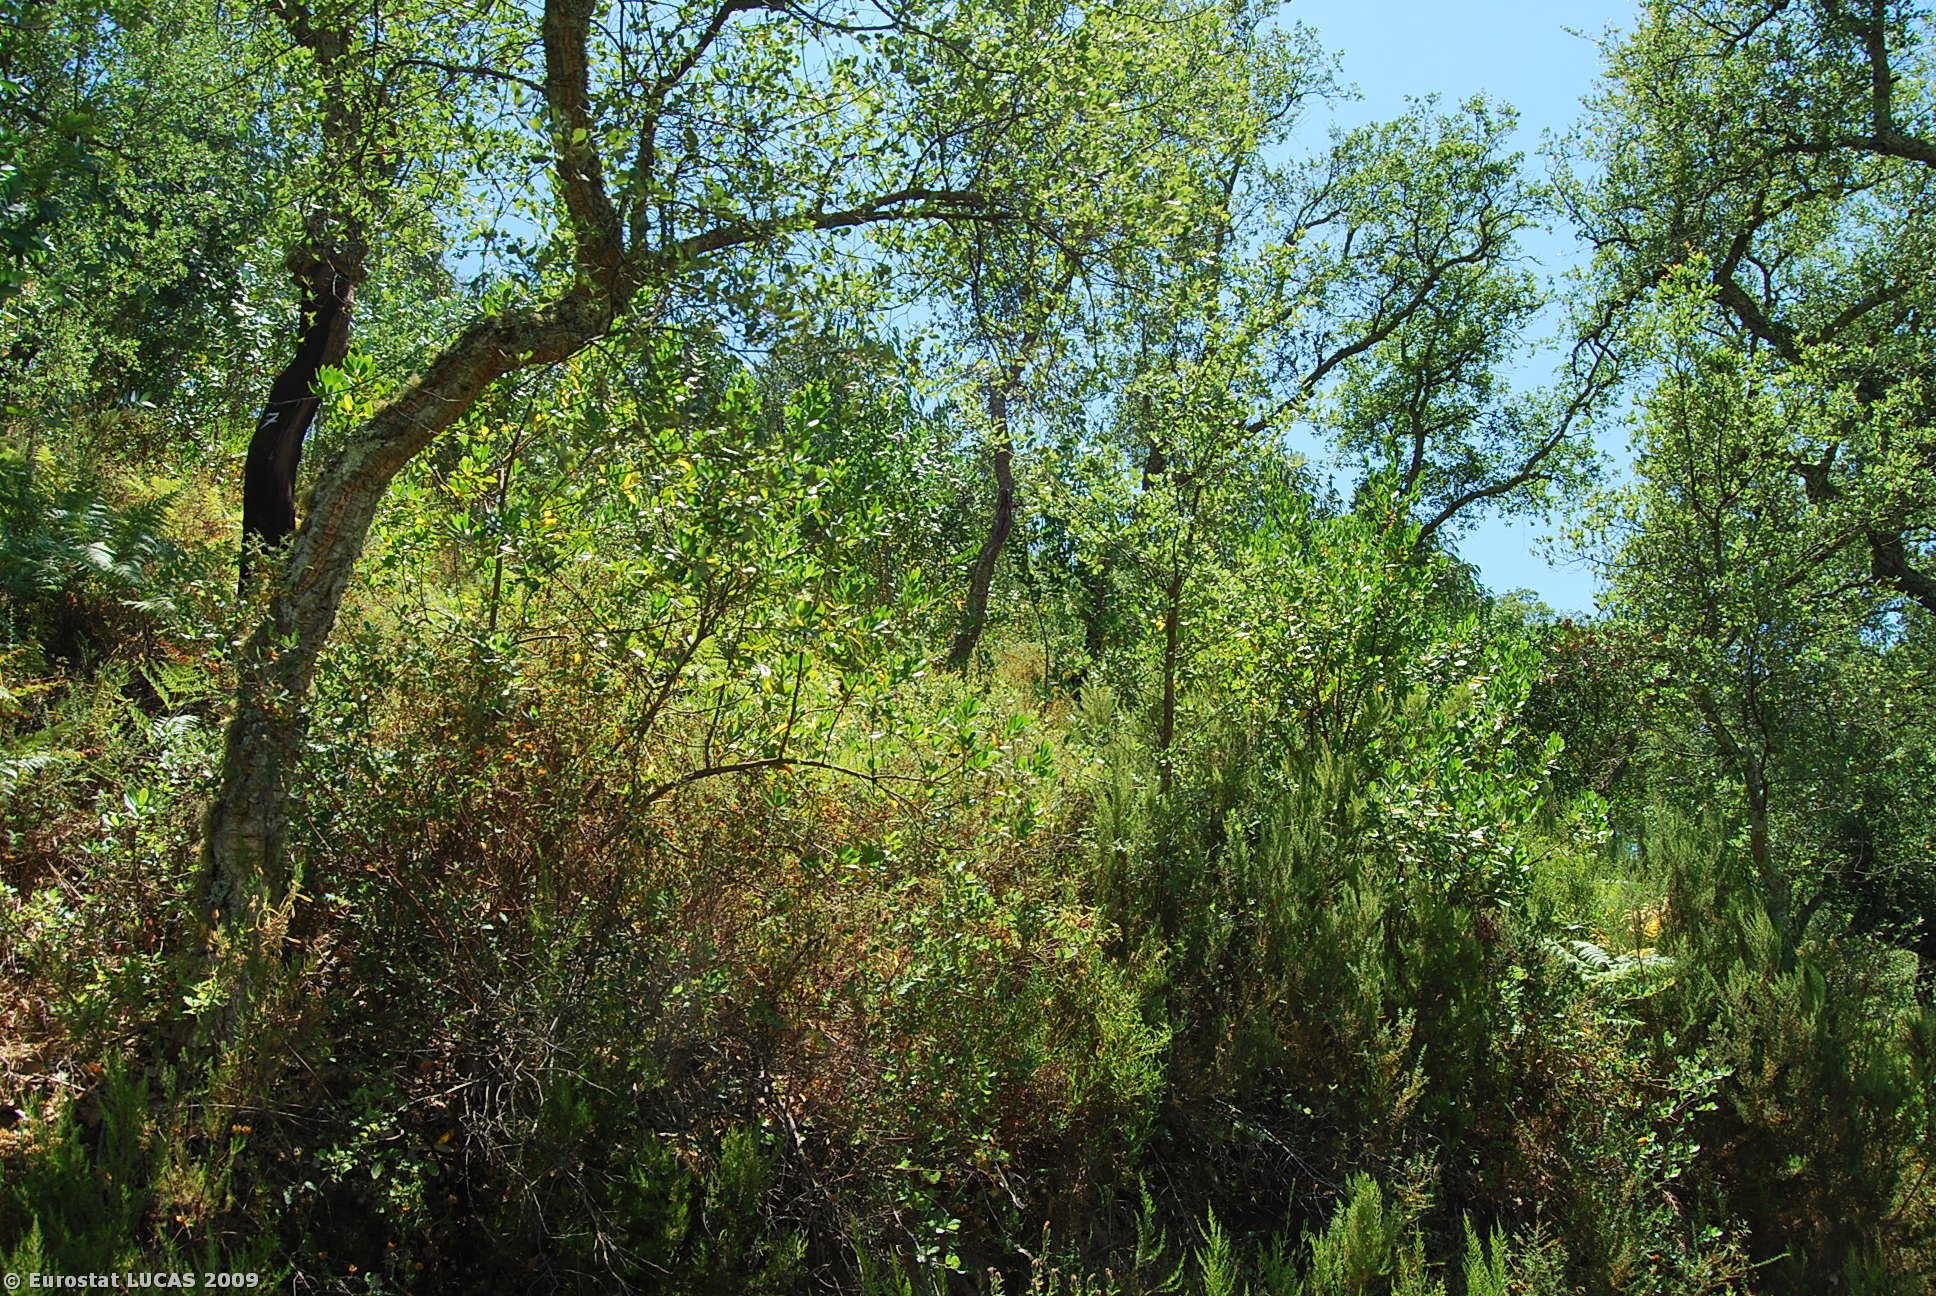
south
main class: Shrubland
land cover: Shrubland with sparse tree cover
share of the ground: > 75 %
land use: Unused
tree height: < 5 m
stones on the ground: 10 - 25 %
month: July
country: PT
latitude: 37.5869
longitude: -8.4817
